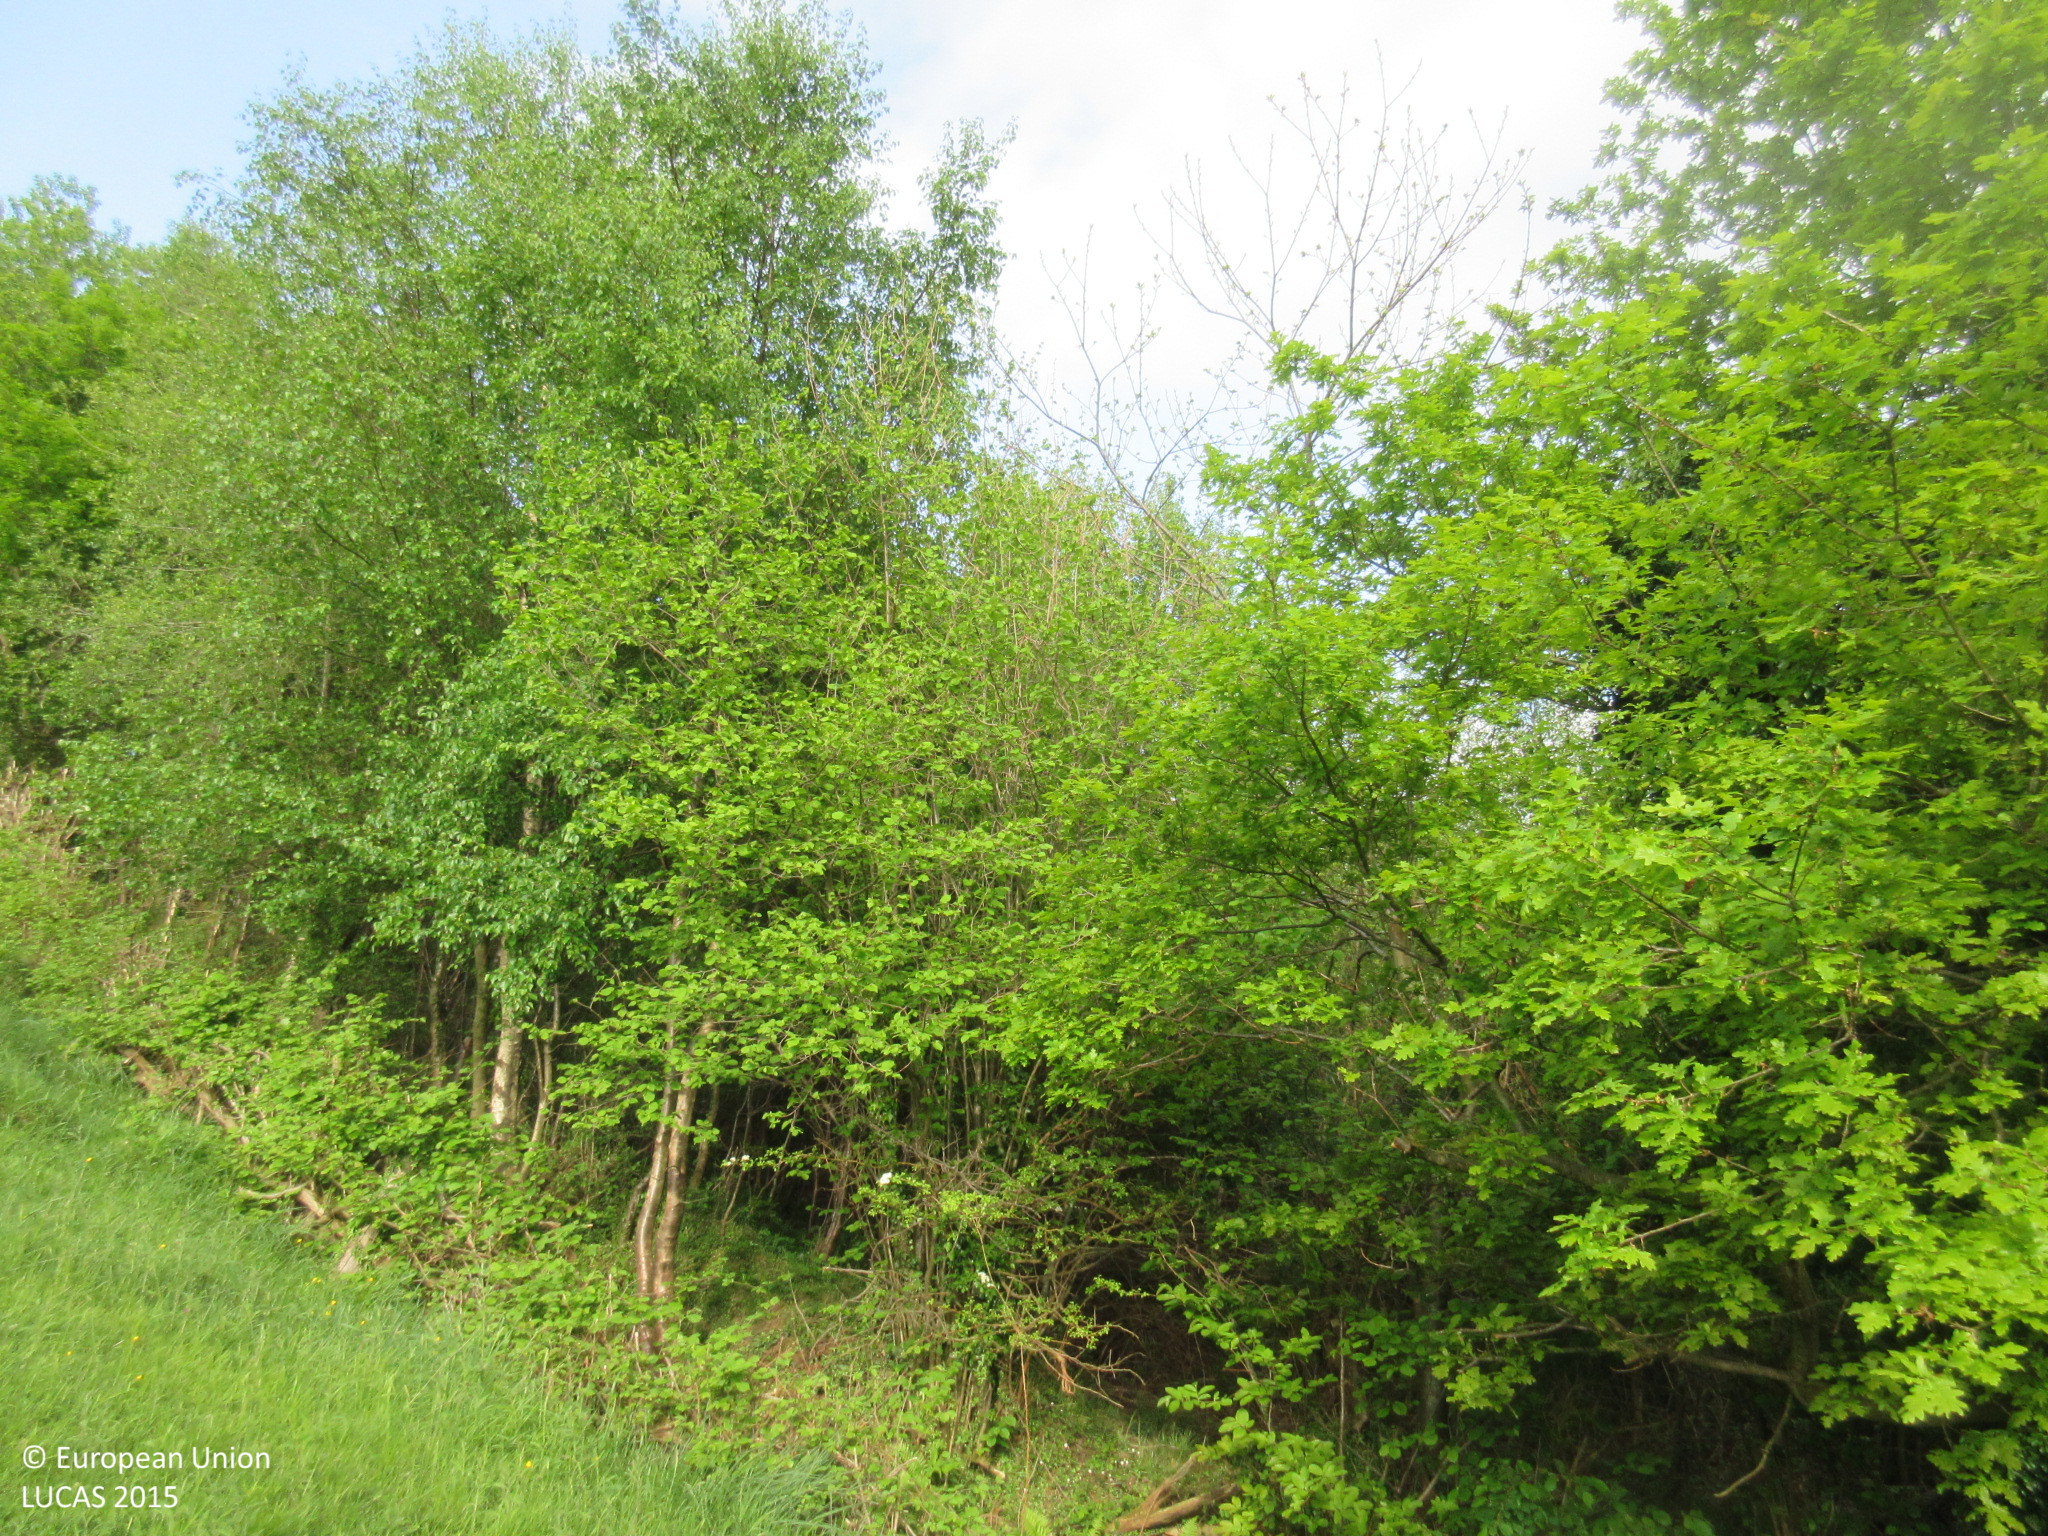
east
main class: Grassland
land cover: Grassland without tree/shrub cover
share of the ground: > 75 %
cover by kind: herbaceous plants 100 %
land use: Agriculture (excluding fallow land and kitchen gardens)
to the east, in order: Grassland without tree/shrub cover; Fences; Tracks; Broadleaved woodland; Grassland with sparse tree/shrub cover; Broadleaved woodland; Tracks; Broadleaved woodland
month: May
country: ES
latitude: 43.2455
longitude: -5.8885
